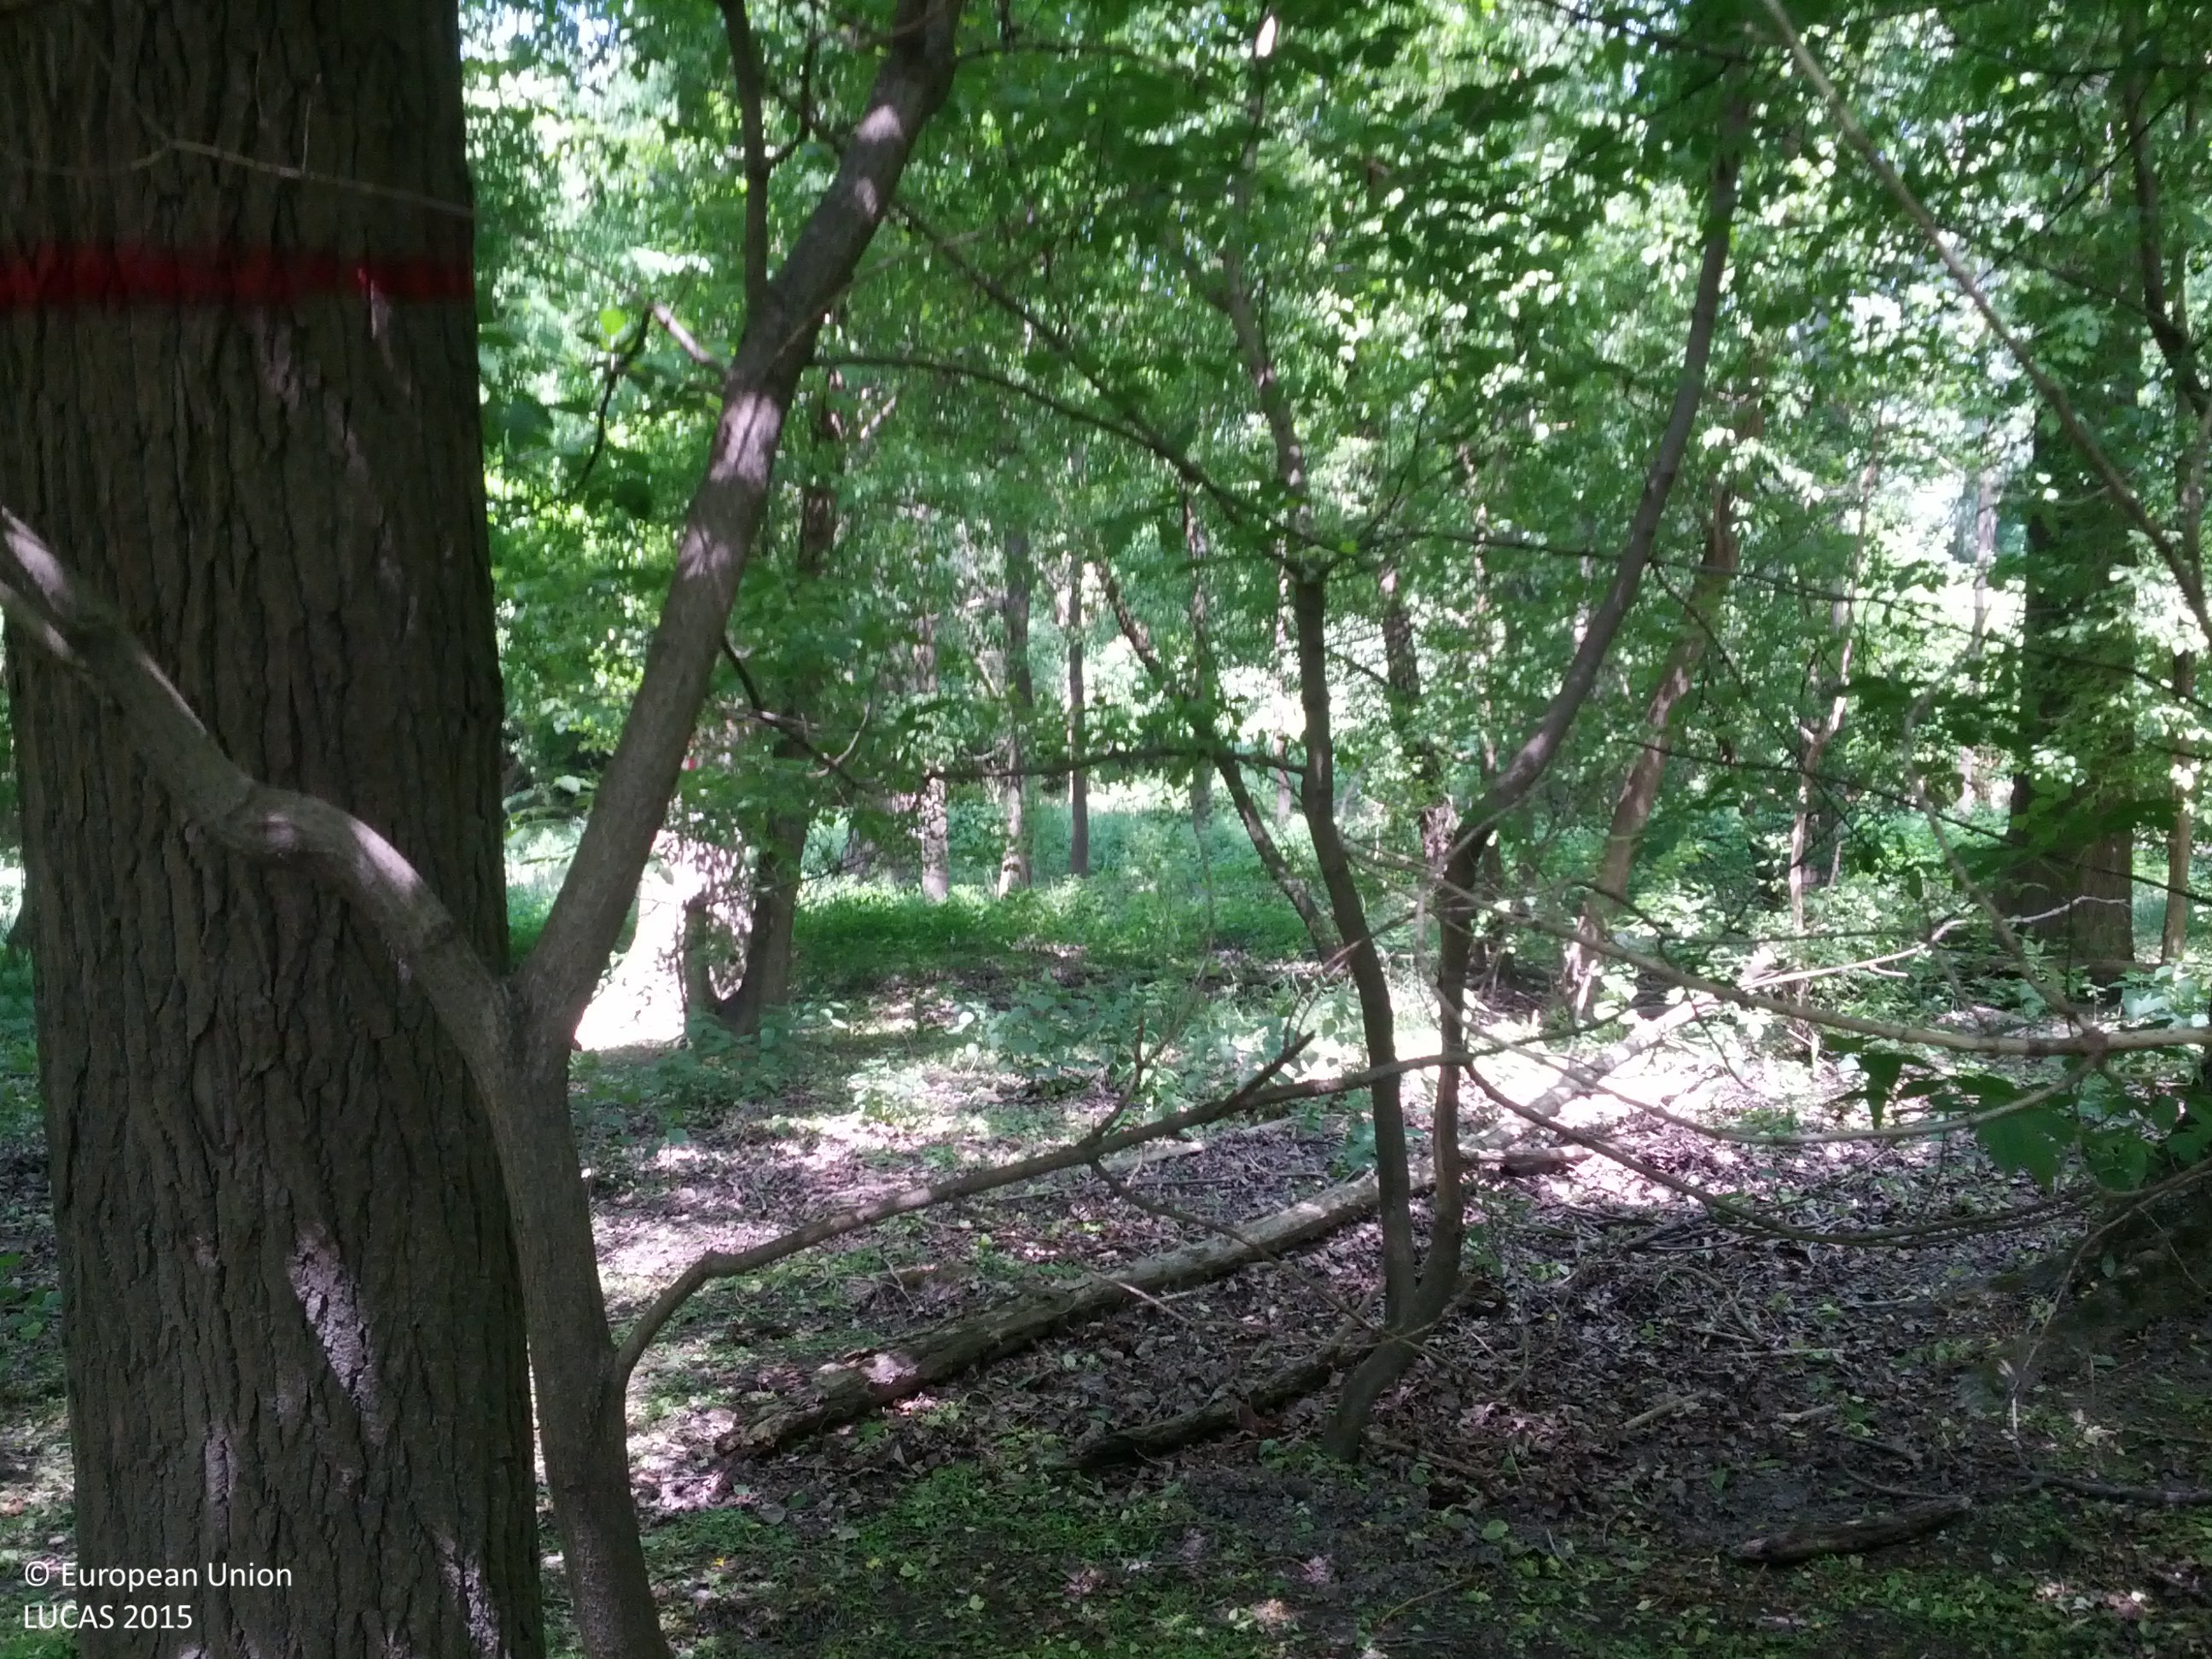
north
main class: Woodland
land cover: Broadleaved woodland
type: floodplain forest
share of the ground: > 75 %
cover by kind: broadleaved forest trees 90 %, shrubs 5 %, herbaceous plants 5 %
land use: Amenities, museums, leisure
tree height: > 5 m
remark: Temporary flooded
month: May
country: AT
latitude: 48.1370
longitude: 16.5499
